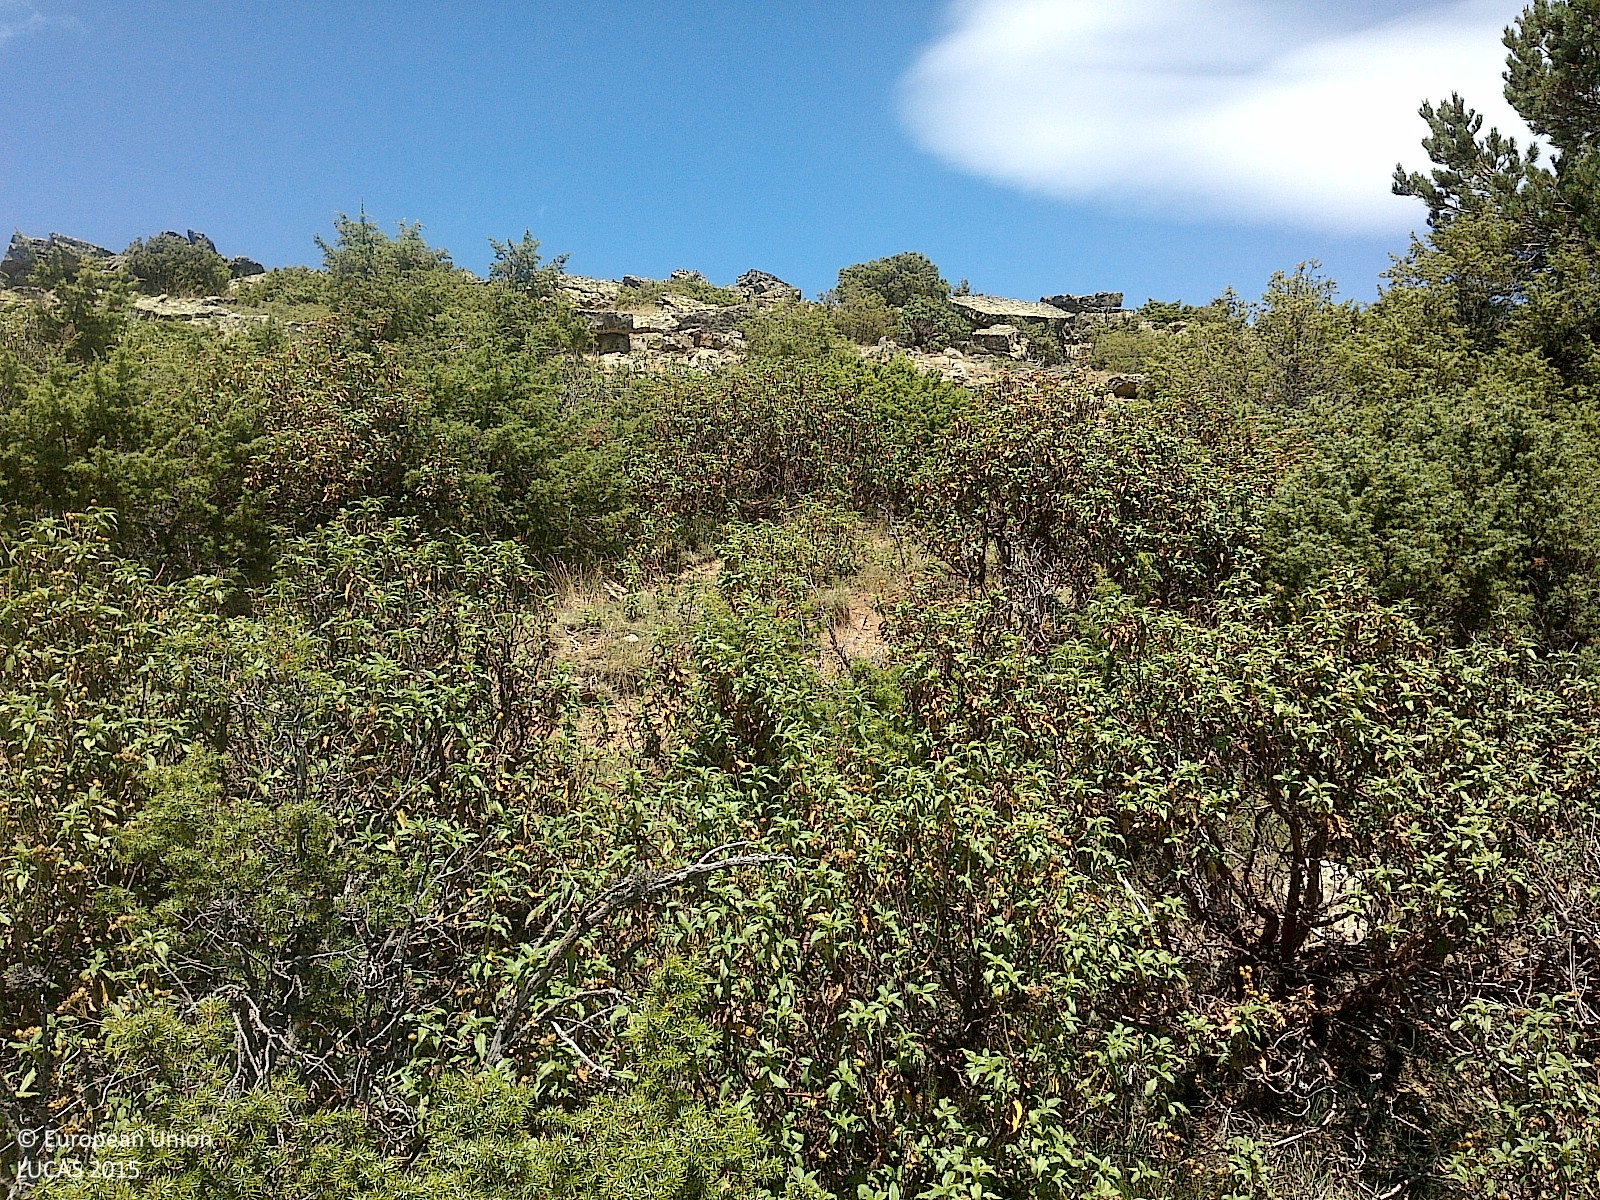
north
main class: Woodland
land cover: Pine dominated coniferous woodland
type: coniferous forest of the mediterranean region
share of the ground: 10 - 25 %
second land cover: Grassland without tree/shrub cover
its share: 25 - 50 %
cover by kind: herbaceous plants 40 %, shrubs 25 %, coniferous forest trees 20 %, unconsolidated bare surface 10 %, consolidated bare surface 5 %
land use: Forestry
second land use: Agriculture (excluding fallow land and kitchen gardens)
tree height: < 5 m
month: July
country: ES
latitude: 41.9962
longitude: -2.1206
